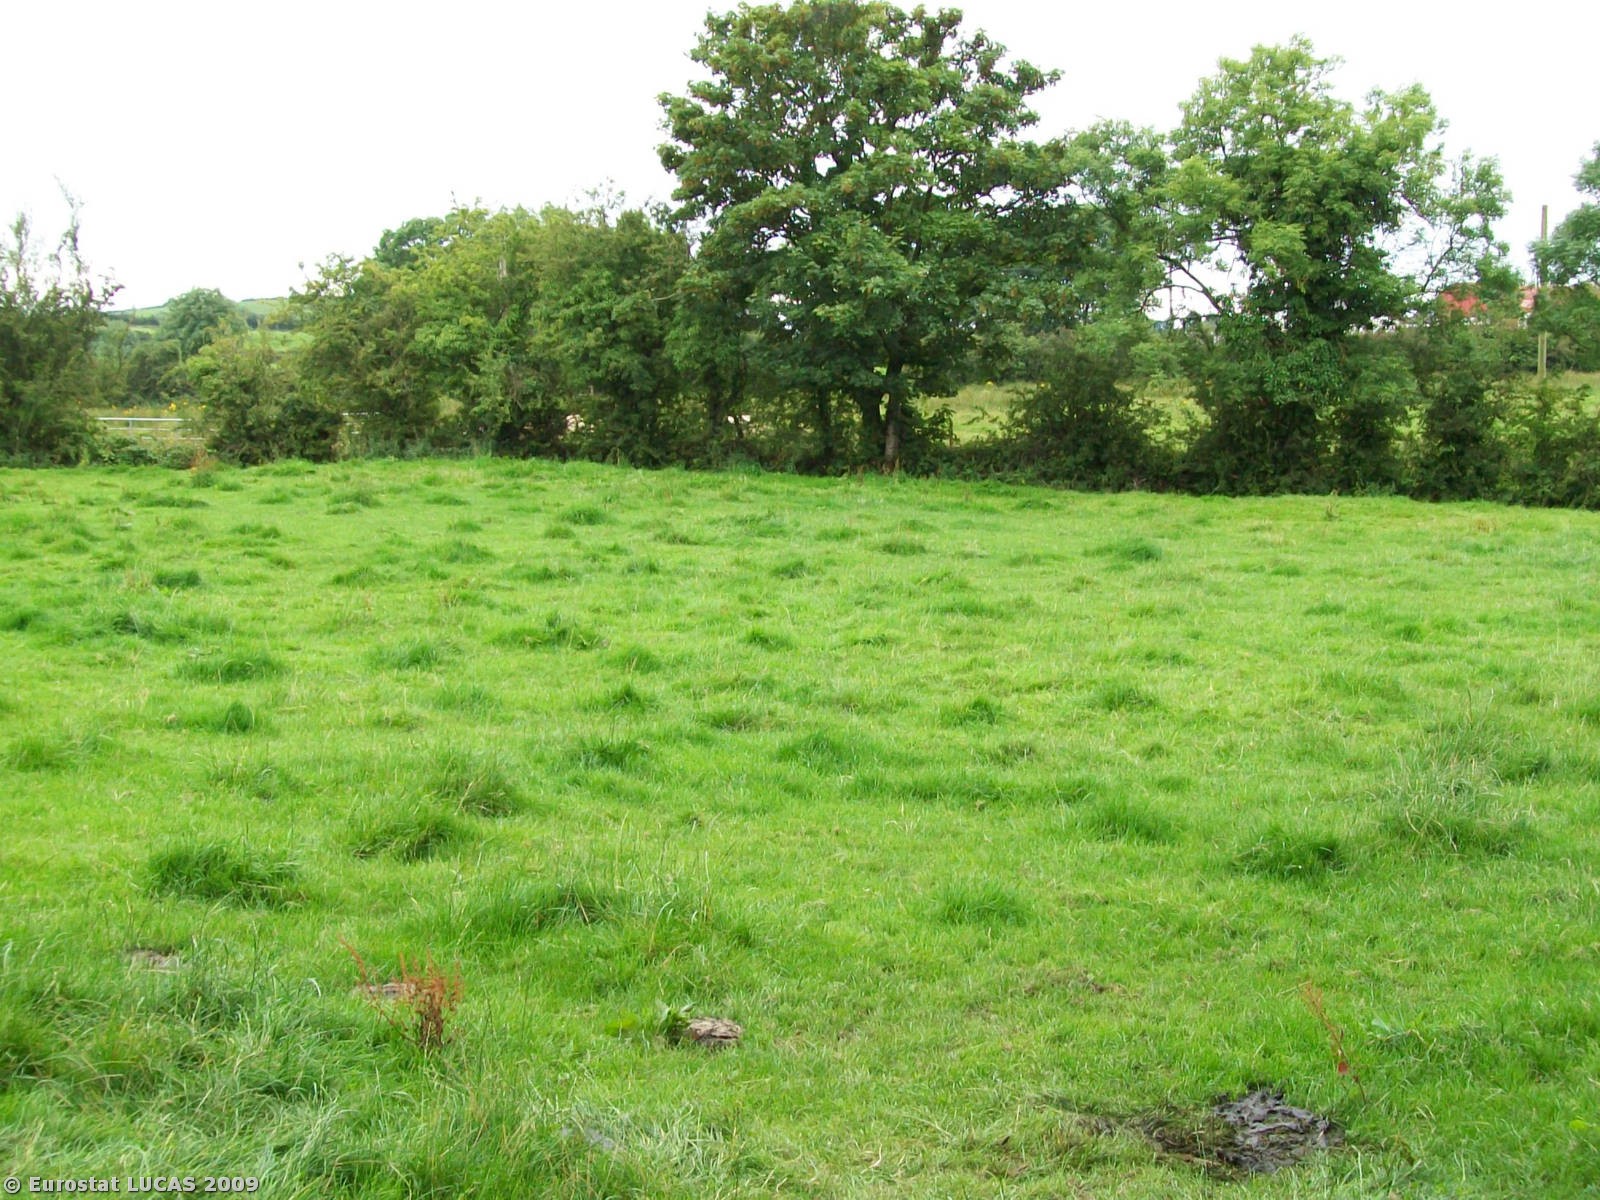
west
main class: Grassland
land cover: Grassland without tree/shrub cover
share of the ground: > 75 %
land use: Agriculture (excluding fallow land and kitchen gardens)
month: August
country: GB
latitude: 54.1364
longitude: -6.6129
